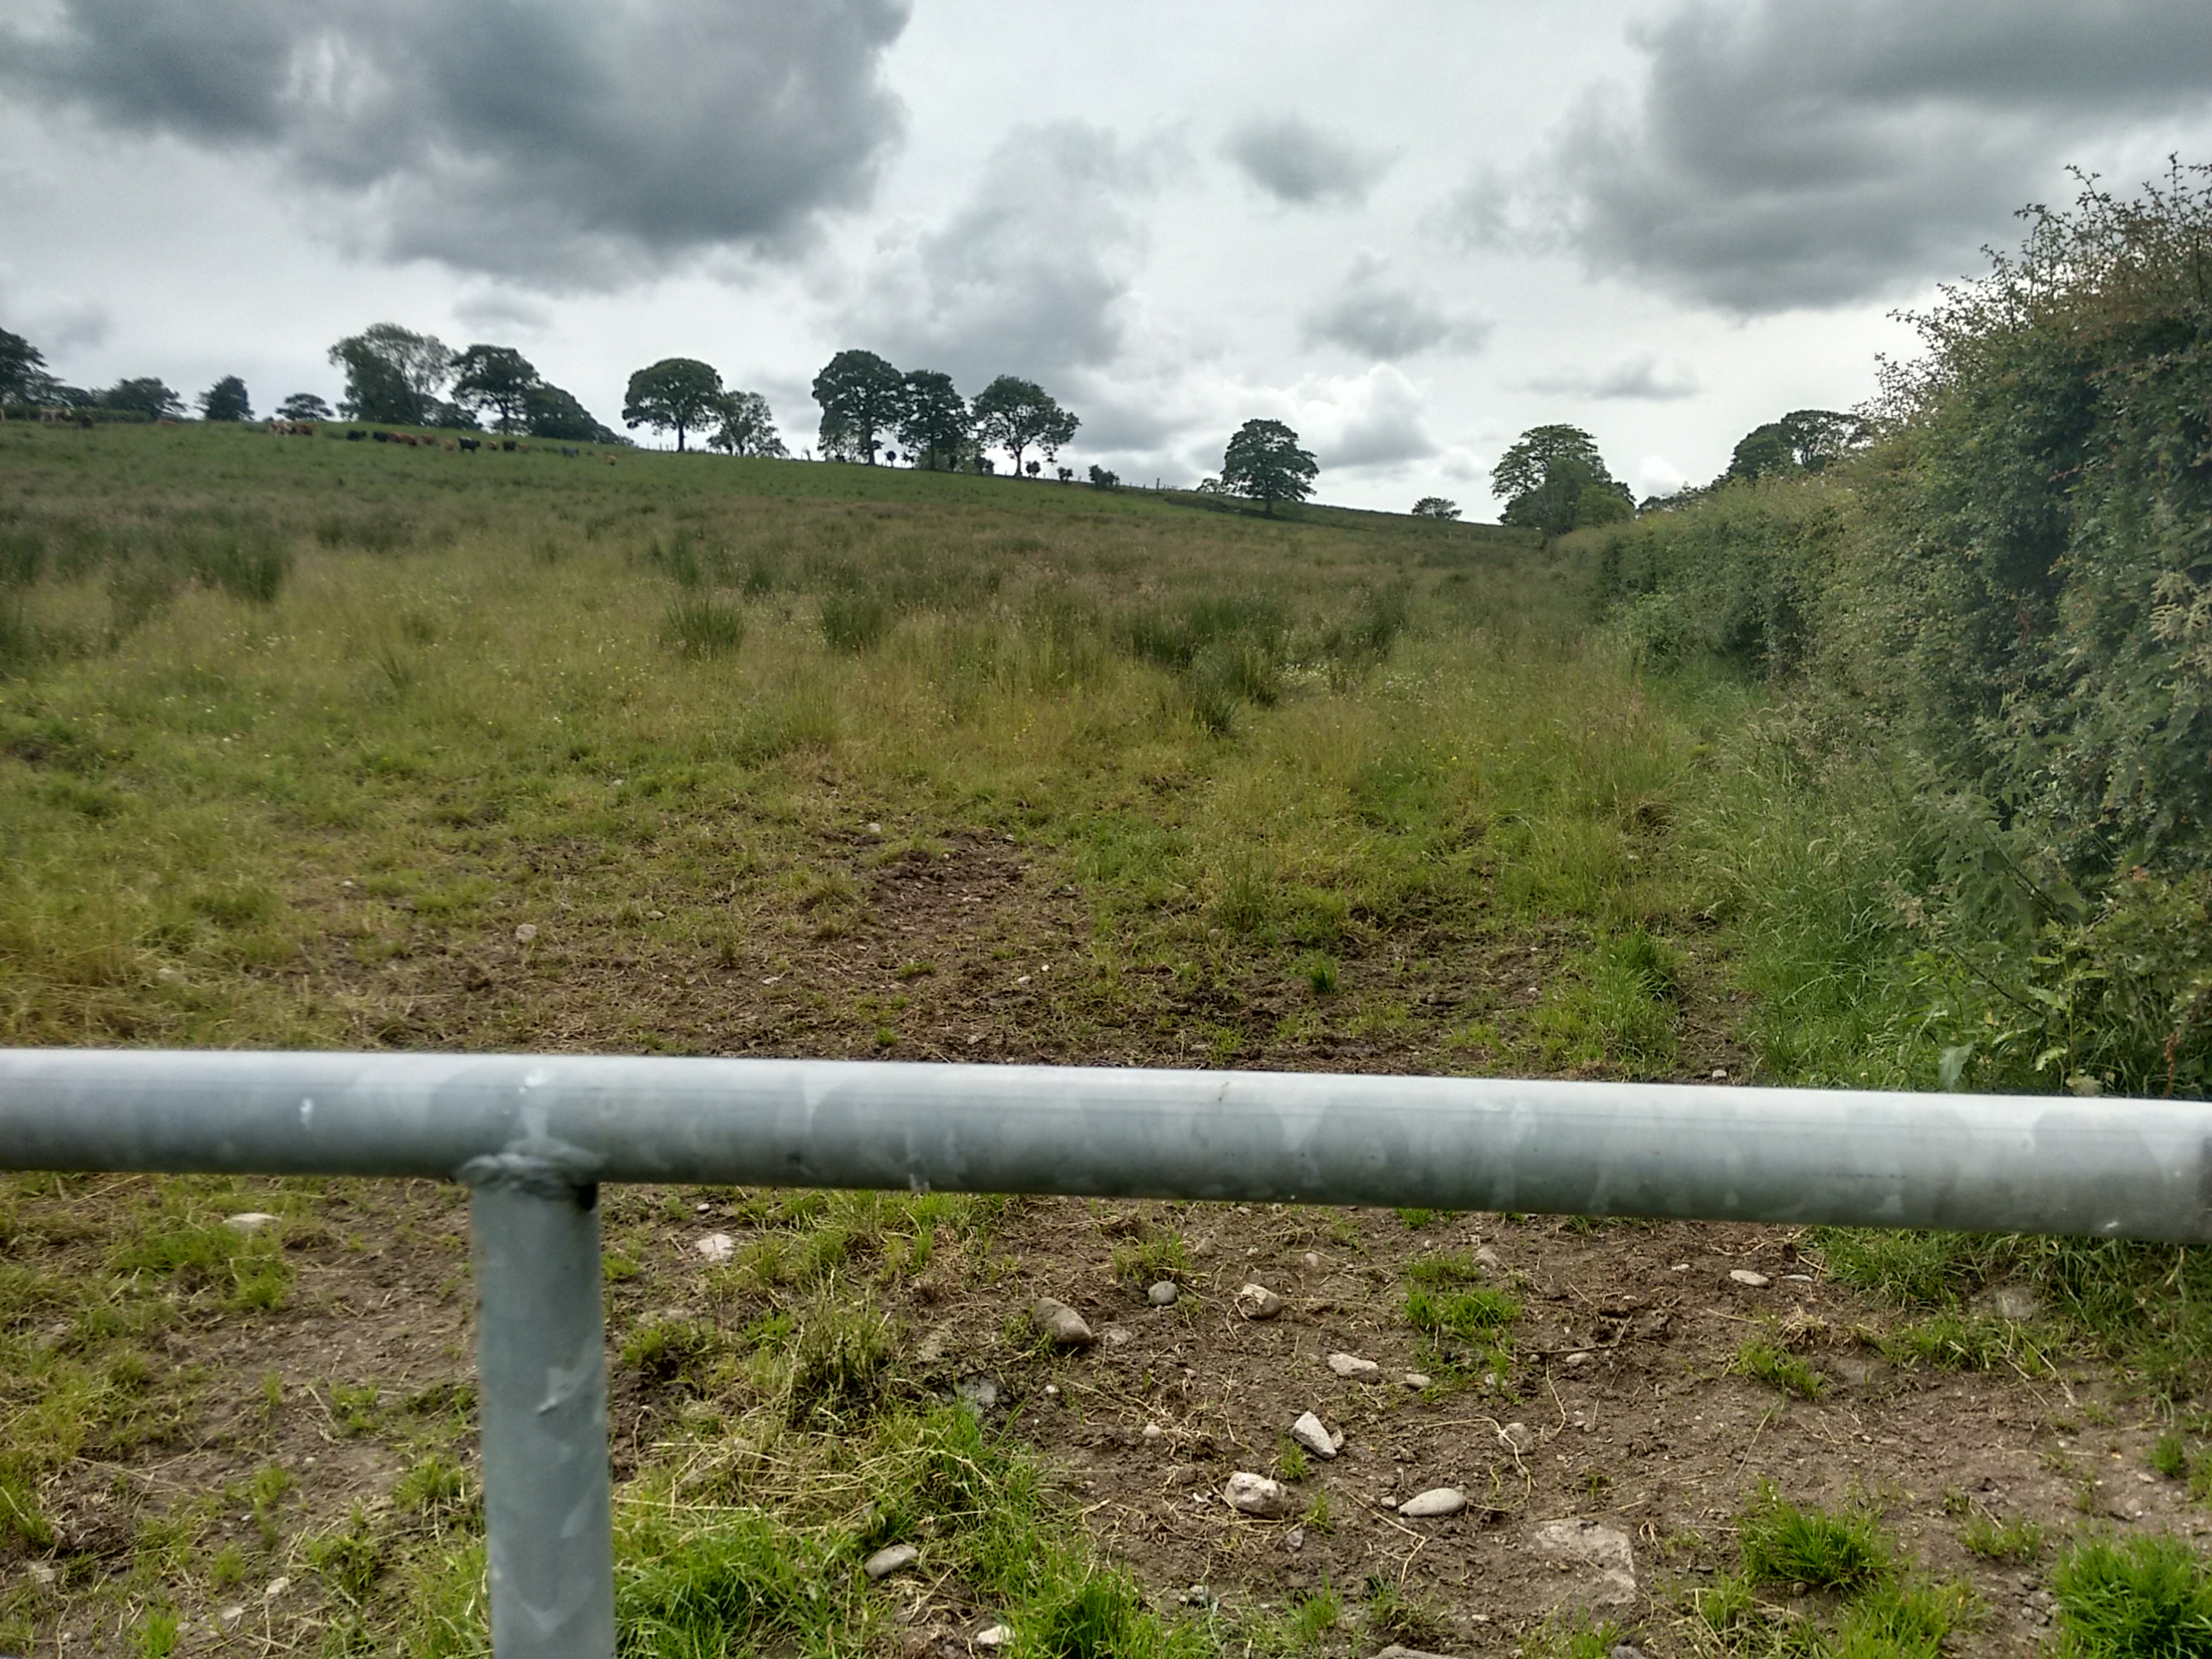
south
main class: Grassland
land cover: Grassland without tree/shrub cover
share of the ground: > 75 %
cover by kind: herbaceous plants 100 %
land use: Agriculture (excluding fallow land and kitchen gardens)
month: July
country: GB
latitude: 54.9034
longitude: -7.1902
